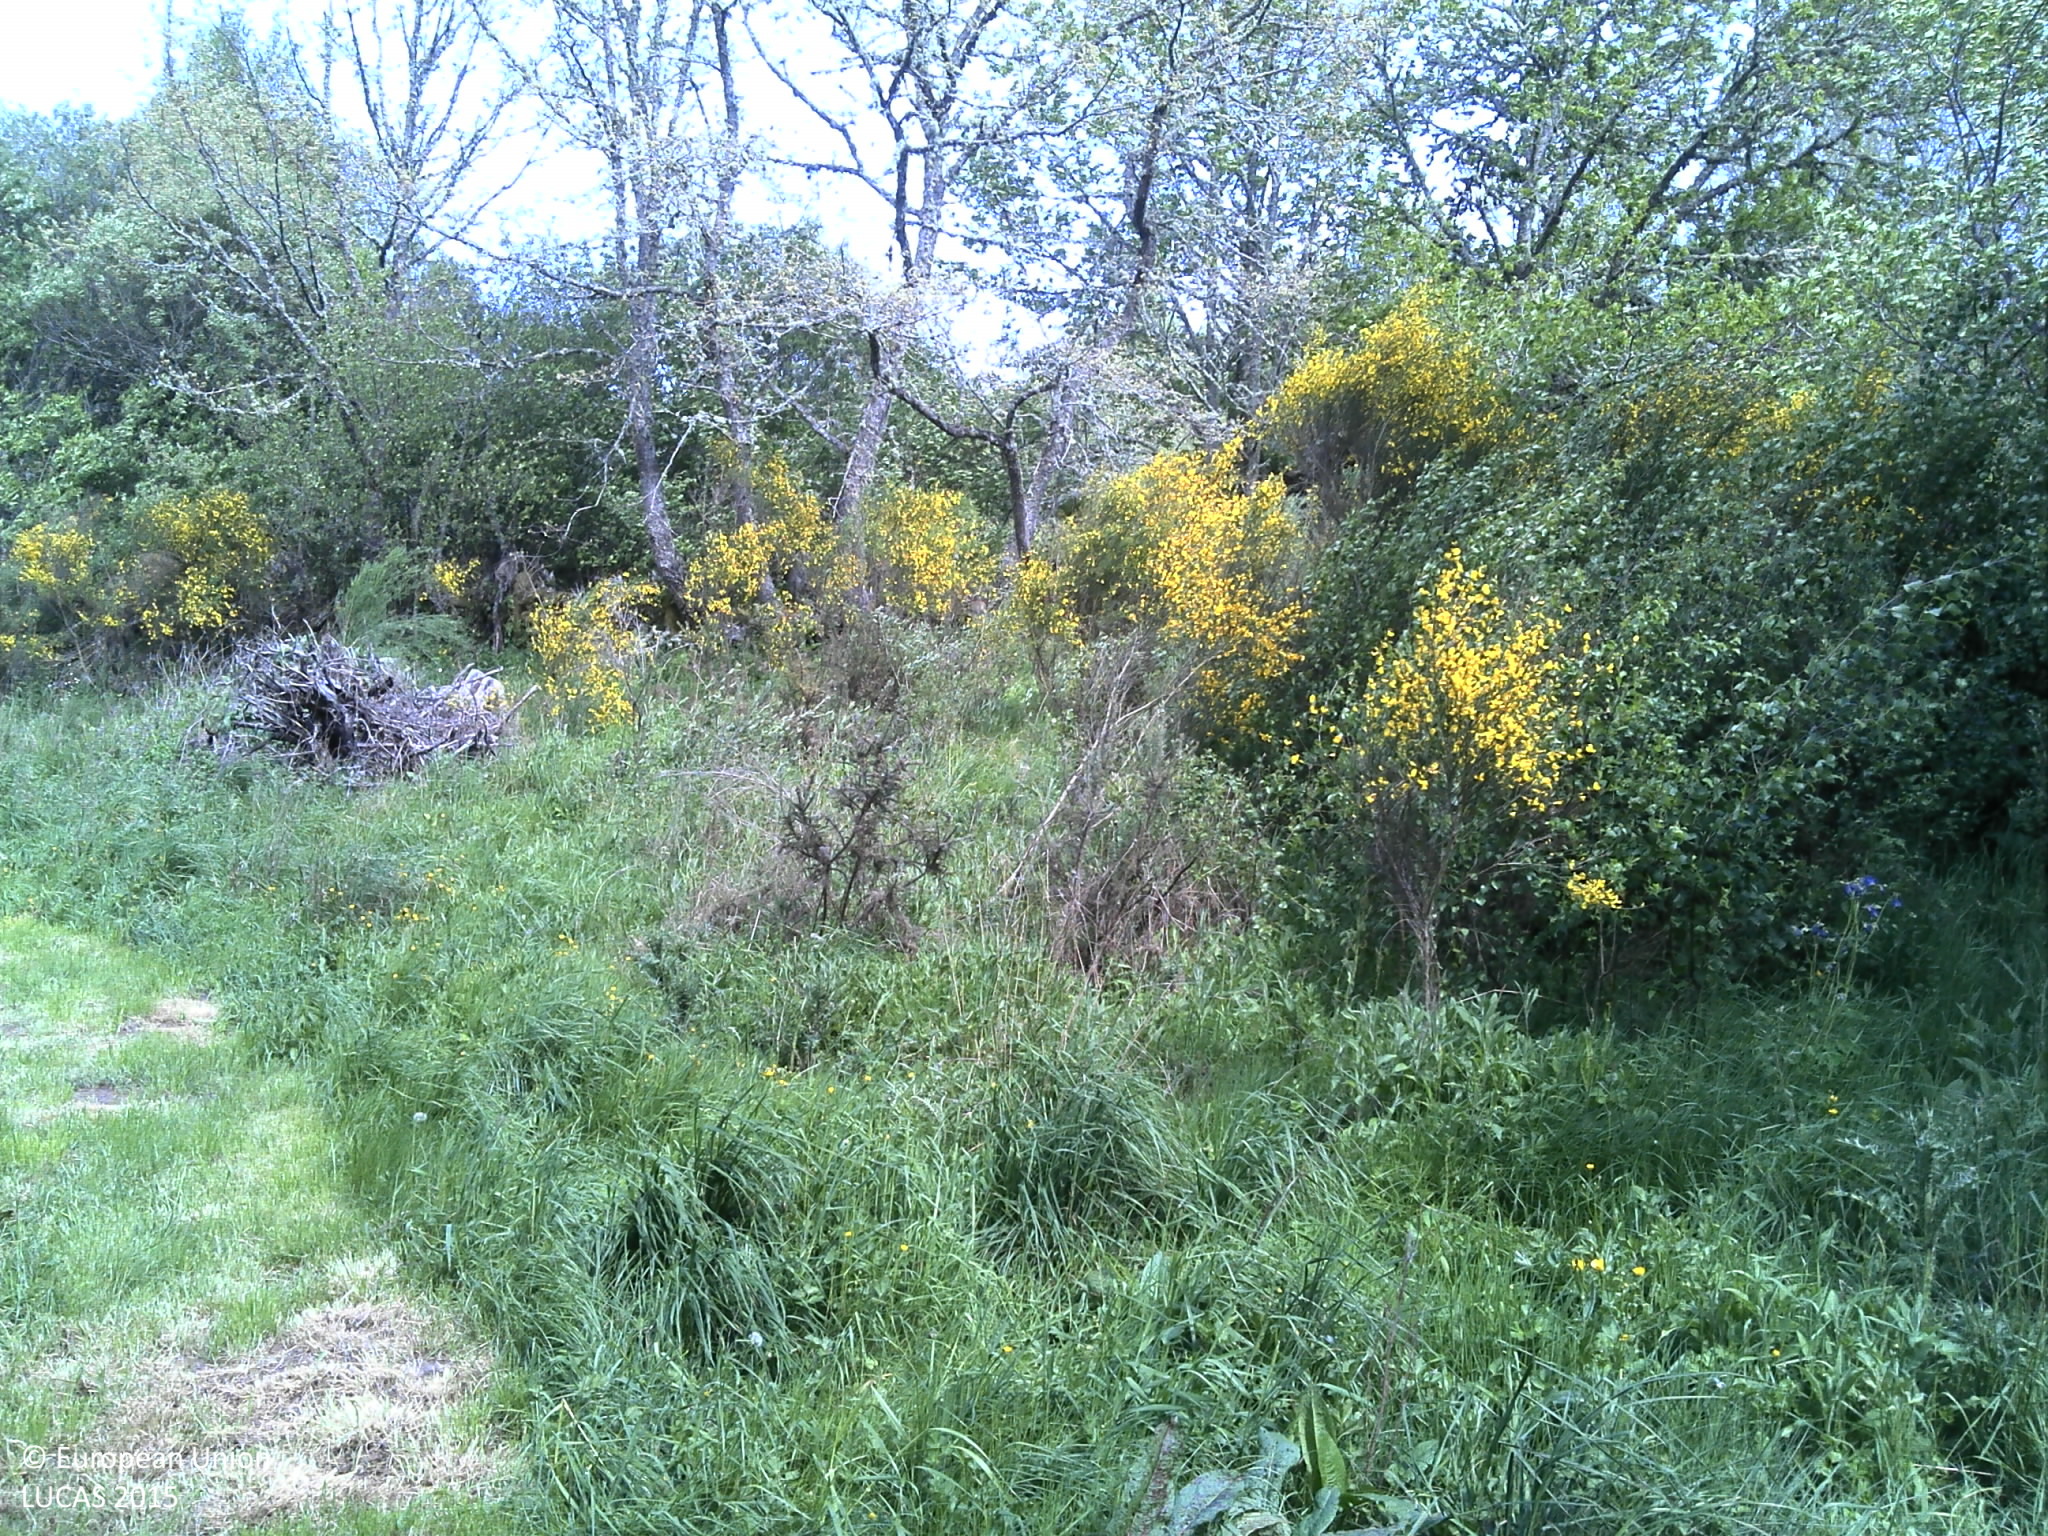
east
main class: Shrubland
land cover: Shrubland with sparse tree cover
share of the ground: 50 - 75 %
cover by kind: shrubs 75 %, herbaceous plants 20 %, broadleaved forest trees 5 %
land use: Semi-natural and natural areas not in use
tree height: > 5 m
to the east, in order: Shrubland with sparse tree cover; Abandoned hedges; Dry stone walls; Shrubland with sparse tree cover; Spontaneously vegetated surfaces; Shrubland without tree cover; Shrubland with sparse tree cover; Broadleaved woodland; Rocks and stones; Shrubland with sparse tree cover
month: May
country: PT
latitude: 41.5327
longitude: -7.5438
